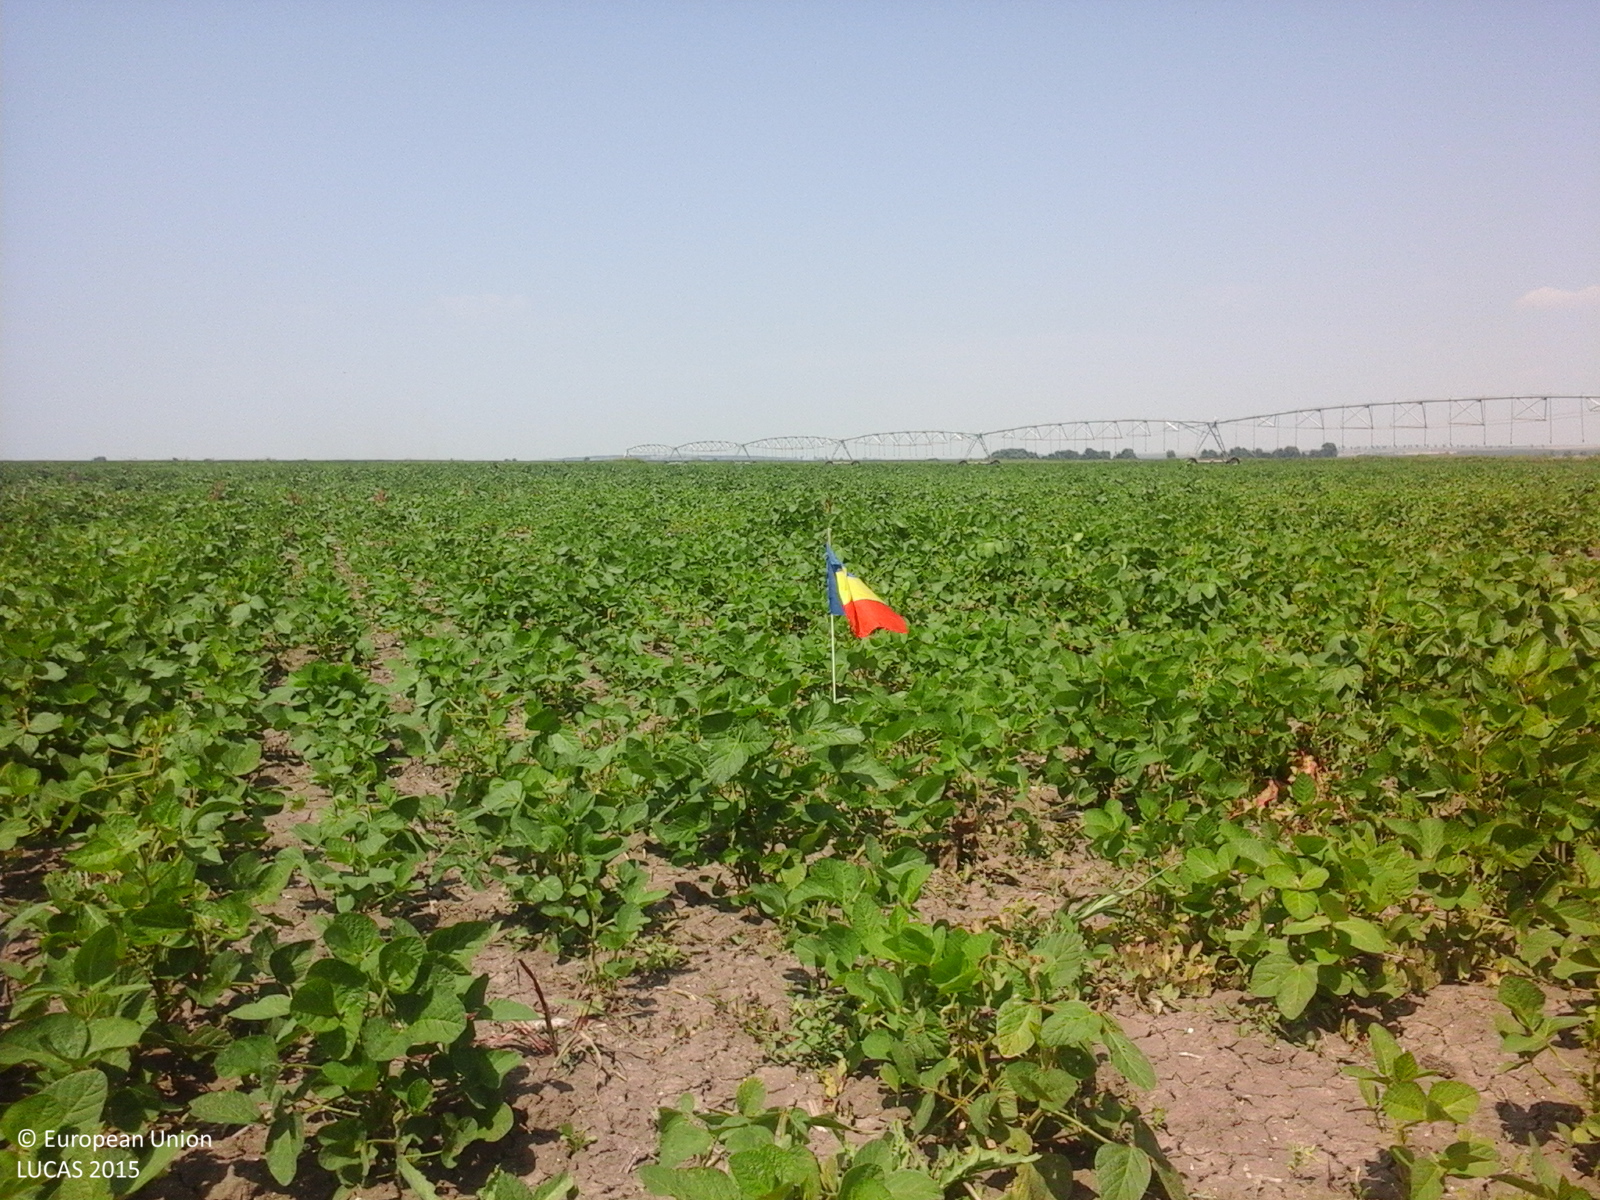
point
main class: Cropland
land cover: Soya
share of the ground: 50 - 75 %
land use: Agriculture (excluding fallow land and kitchen gardens)
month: July
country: RO
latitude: 44.5722
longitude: 27.9764
